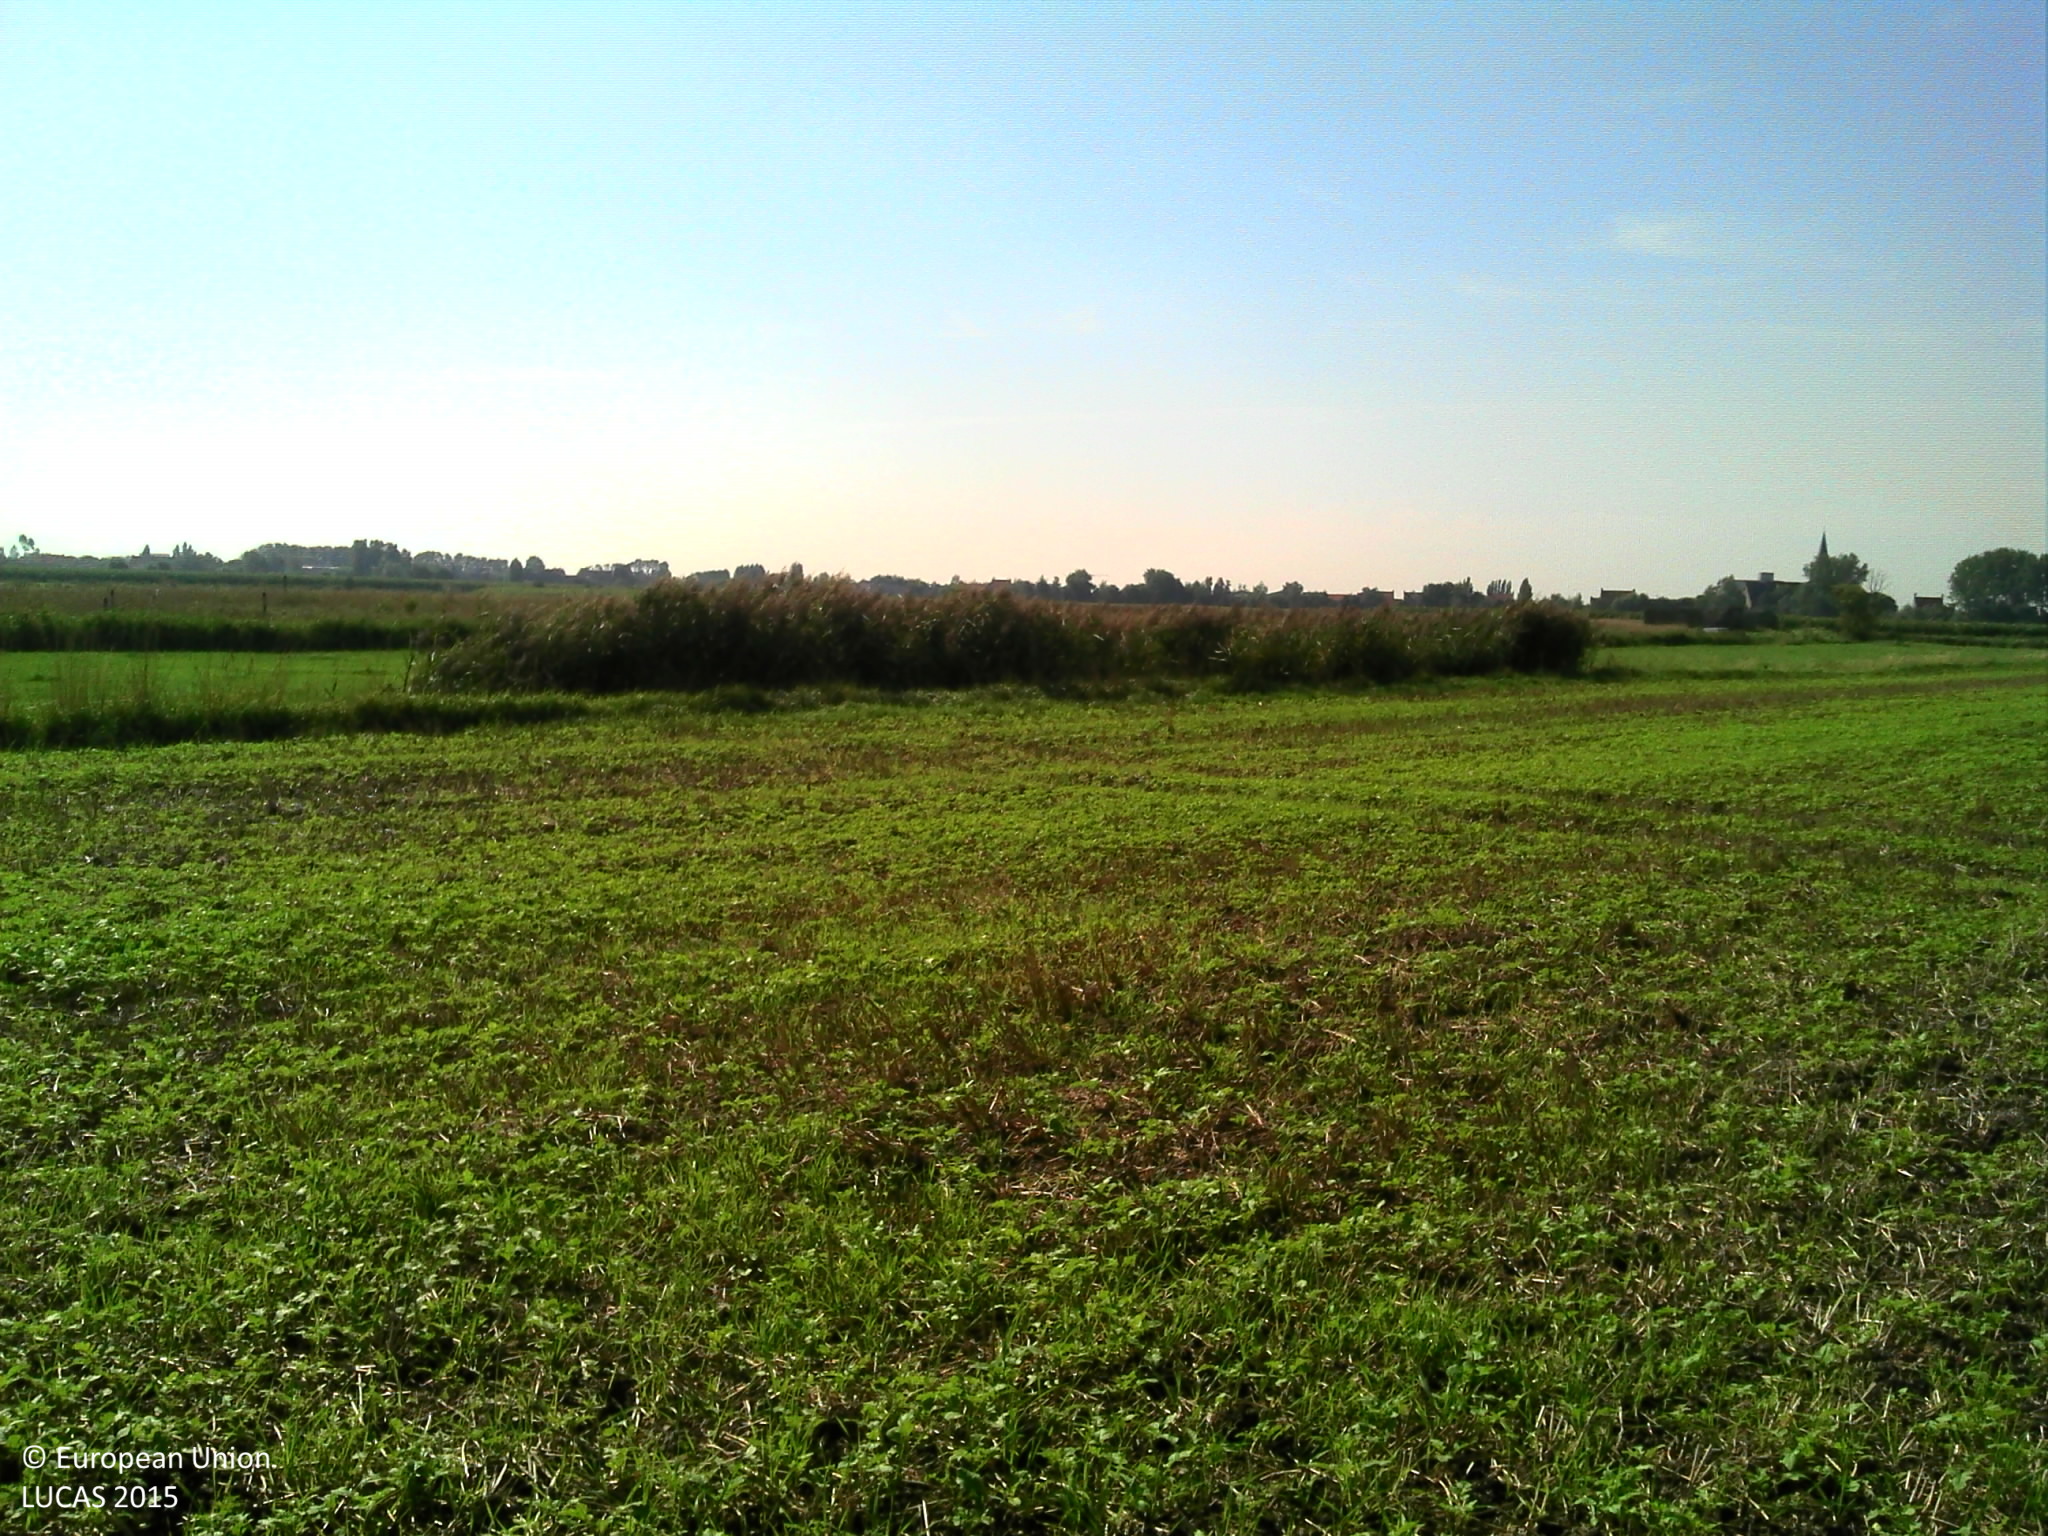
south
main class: Cropland
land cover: Other fibre and oleaginous crops
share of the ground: 50 - 75 %
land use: Agriculture (excluding fallow land and kitchen gardens)
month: September
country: BE
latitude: 51.0424
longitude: 2.8434
